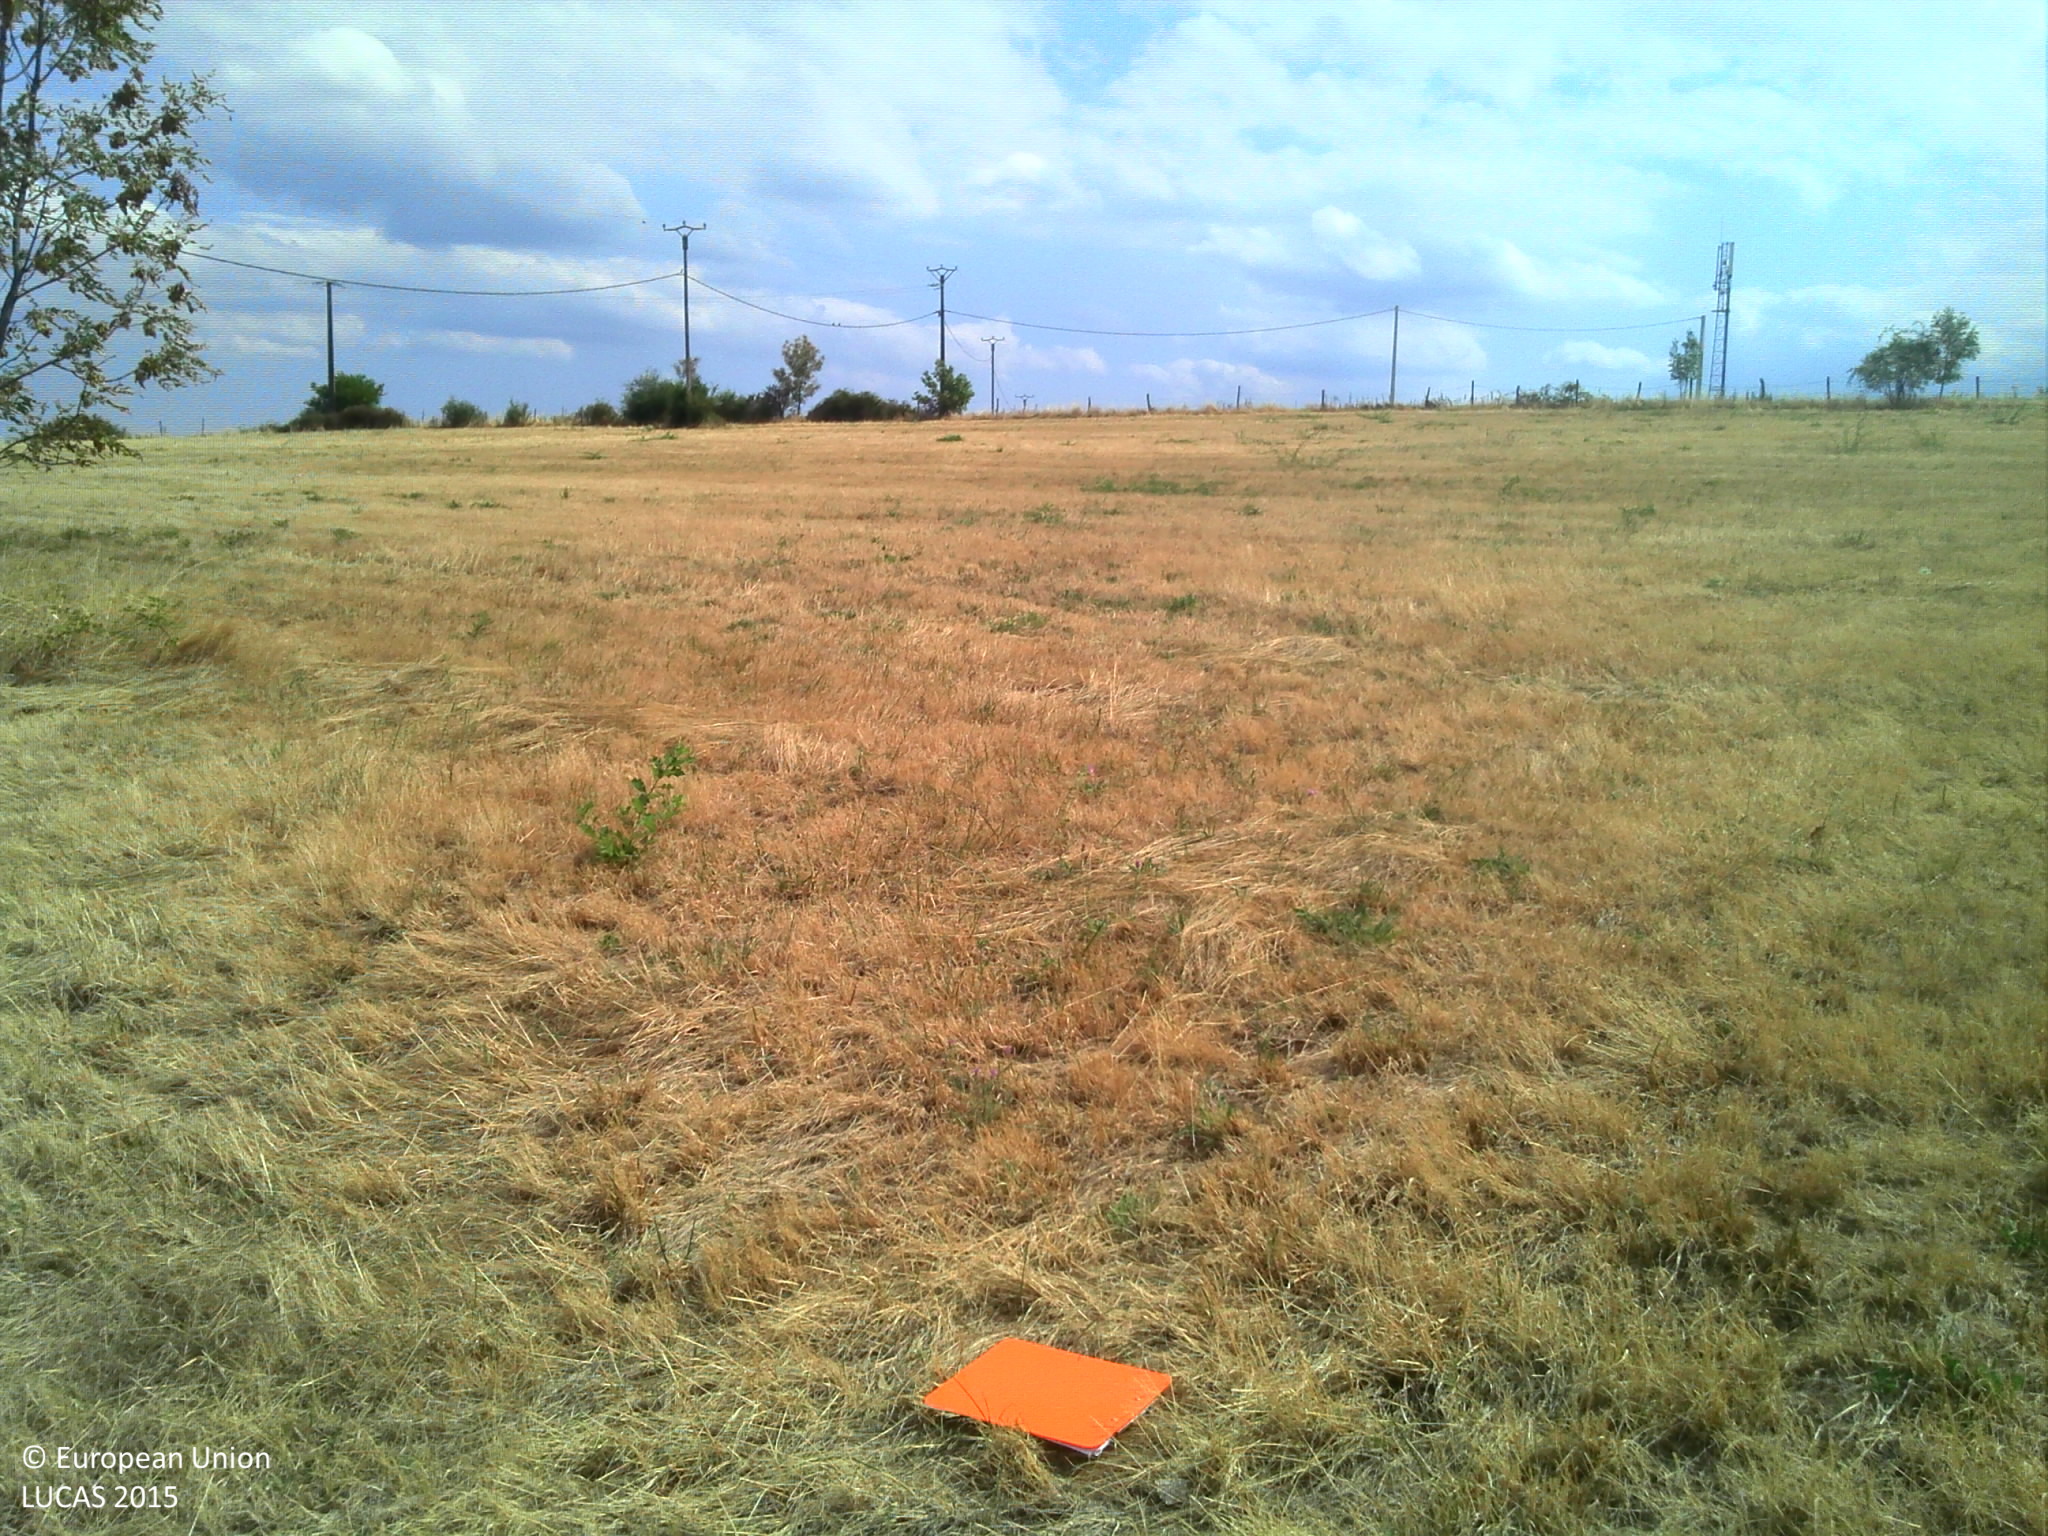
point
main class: Grassland
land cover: Grassland without tree/shrub cover
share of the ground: > 75 %
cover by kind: herbaceous plants 100 %
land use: Agriculture (excluding fallow land and kitchen gardens)
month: August
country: FR
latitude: 45.6604
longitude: 4.7031
